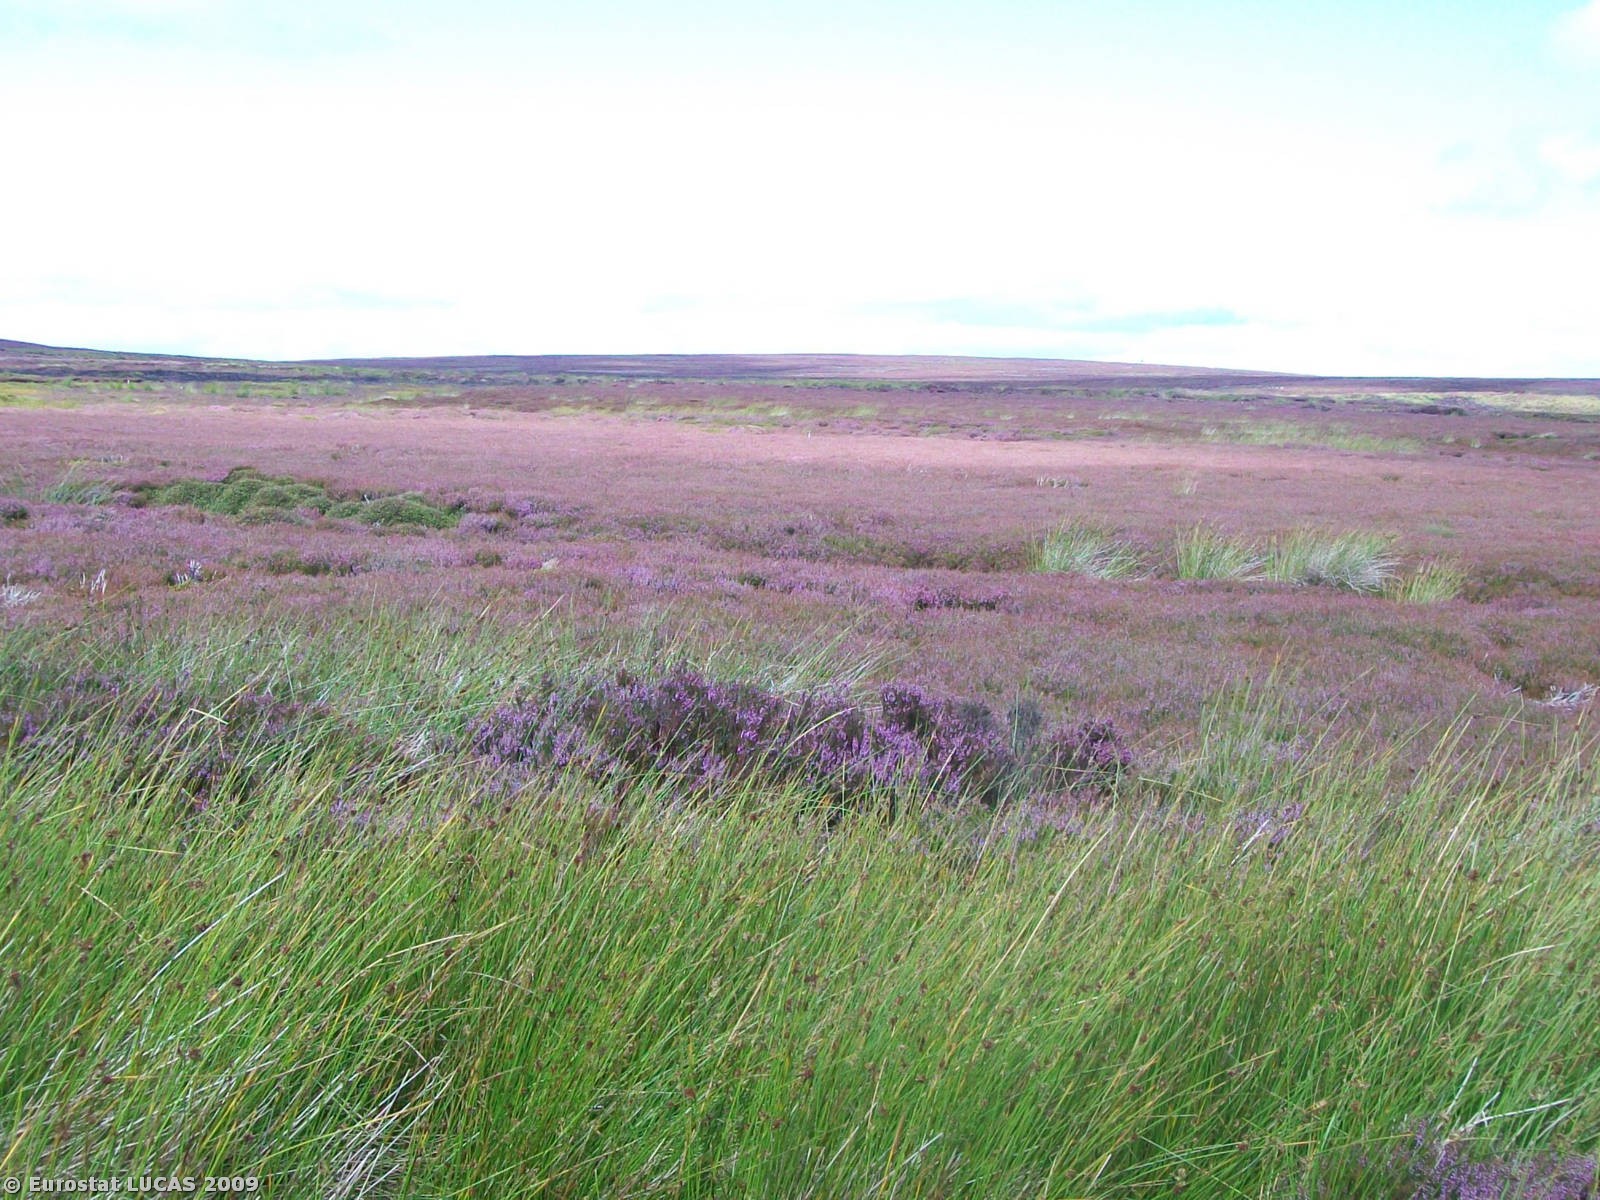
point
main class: Shrubland
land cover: Shrubland without tree cover
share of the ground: > 75 %
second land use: Nature reserves
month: August
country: GB
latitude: 54.1530
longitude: -1.7665
